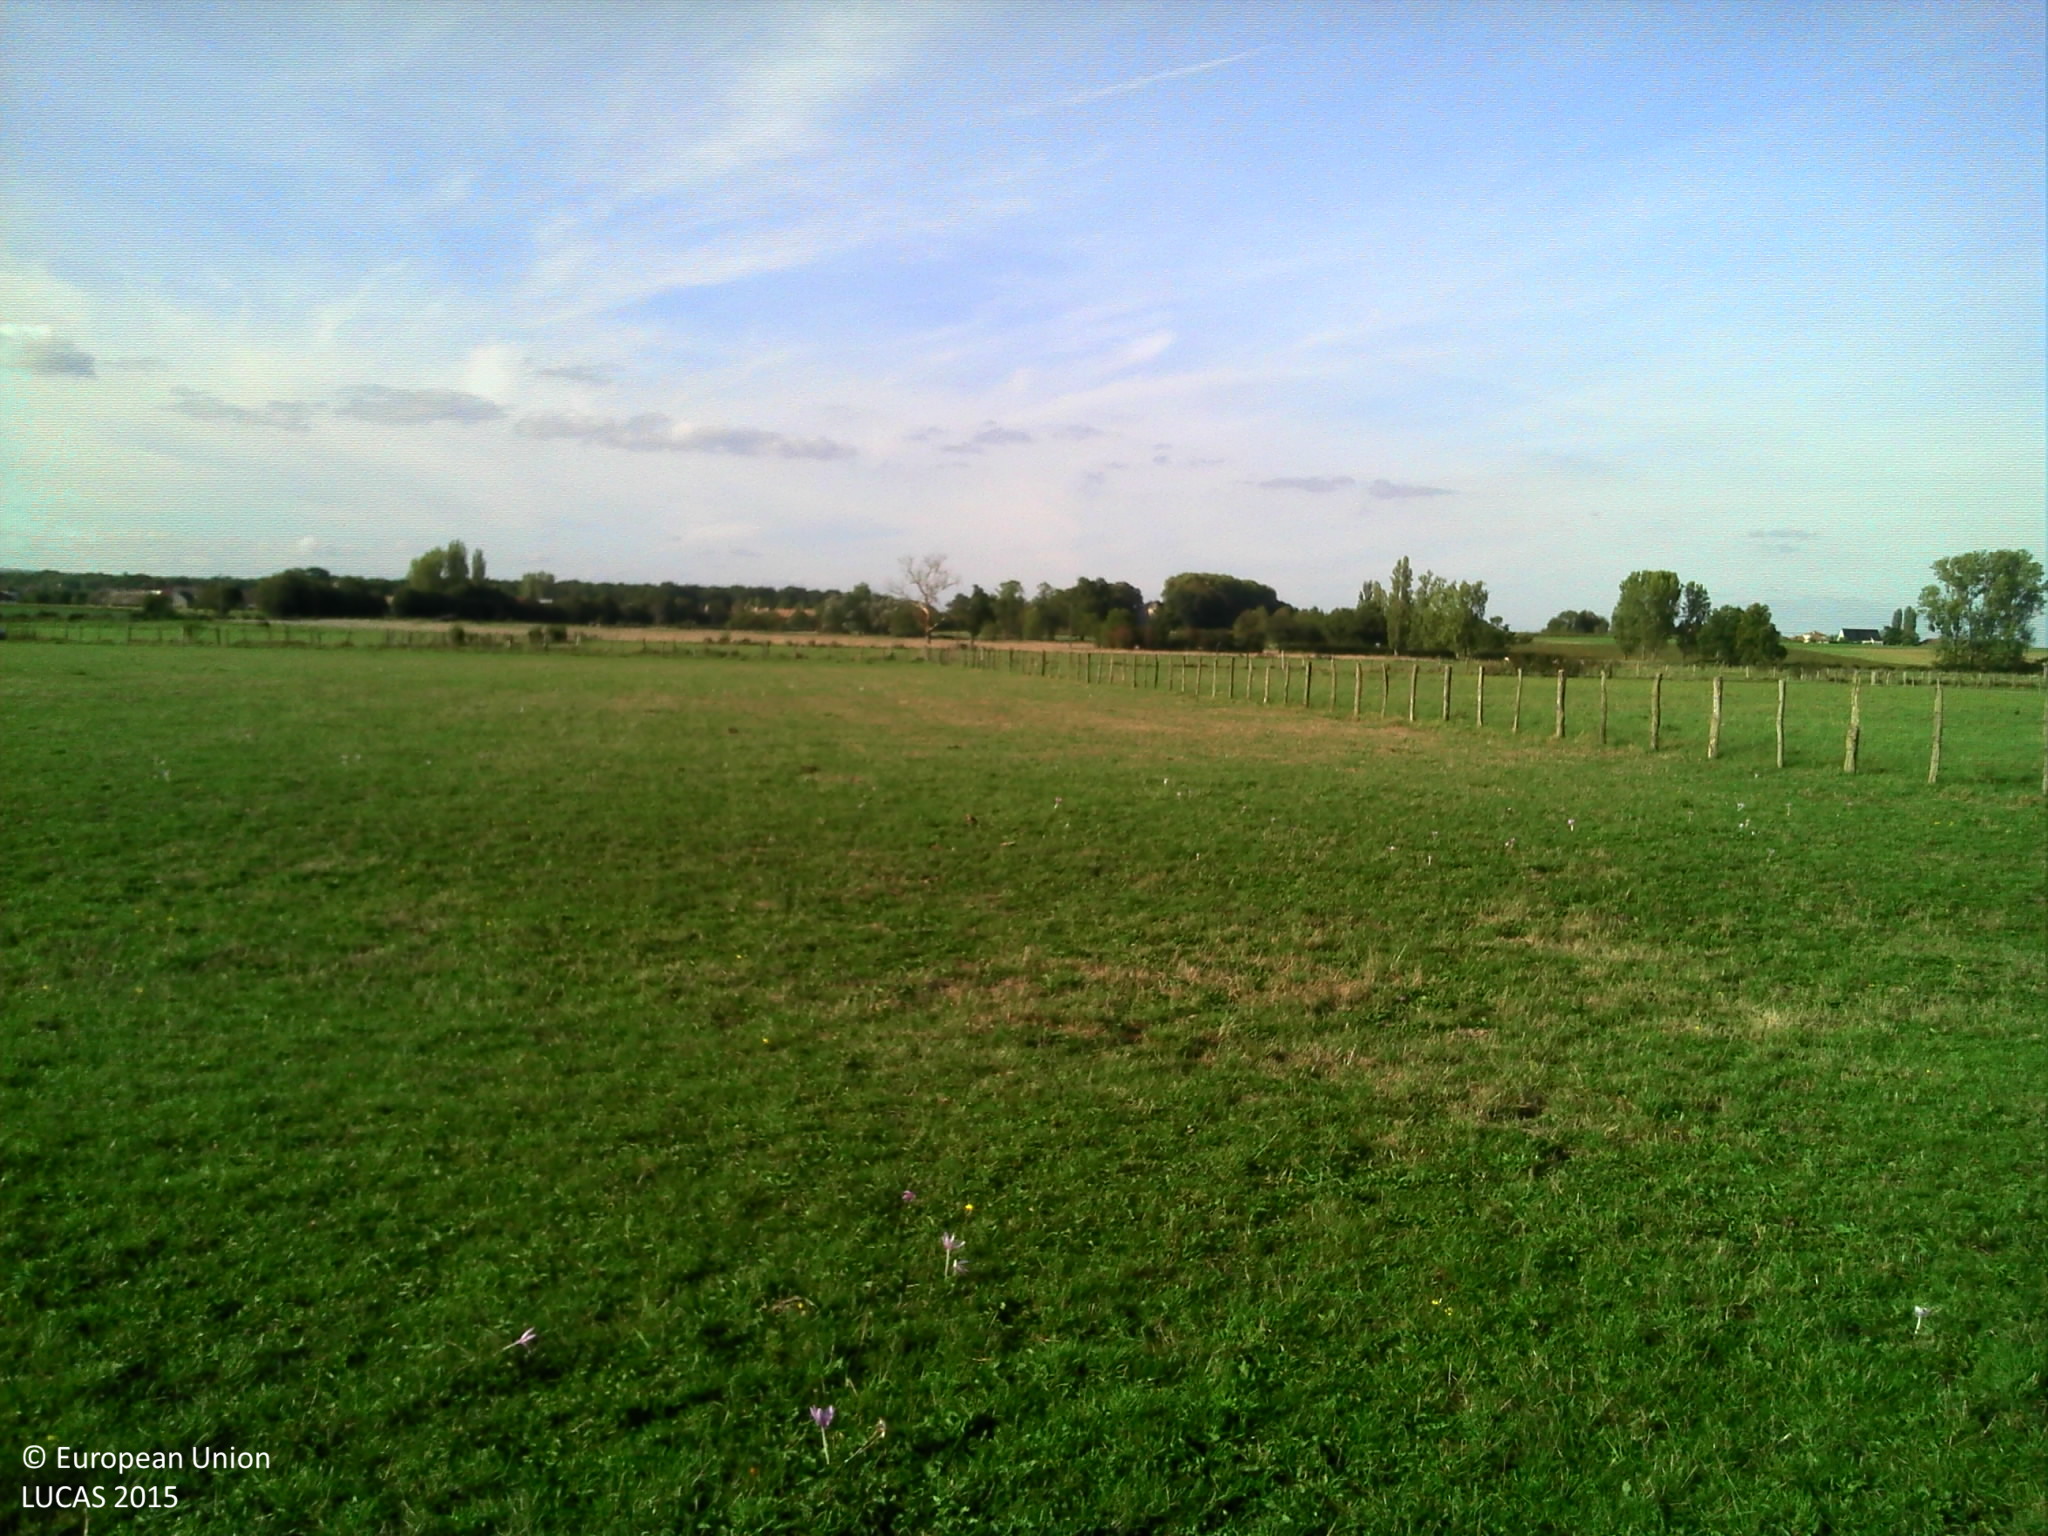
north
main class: Grassland
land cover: Grassland without tree/shrub cover
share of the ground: > 75 %
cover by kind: herbaceous plants 100 %
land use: Agriculture (excluding fallow land and kitchen gardens)
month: September
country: FR
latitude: 46.9496
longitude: 4.8637
